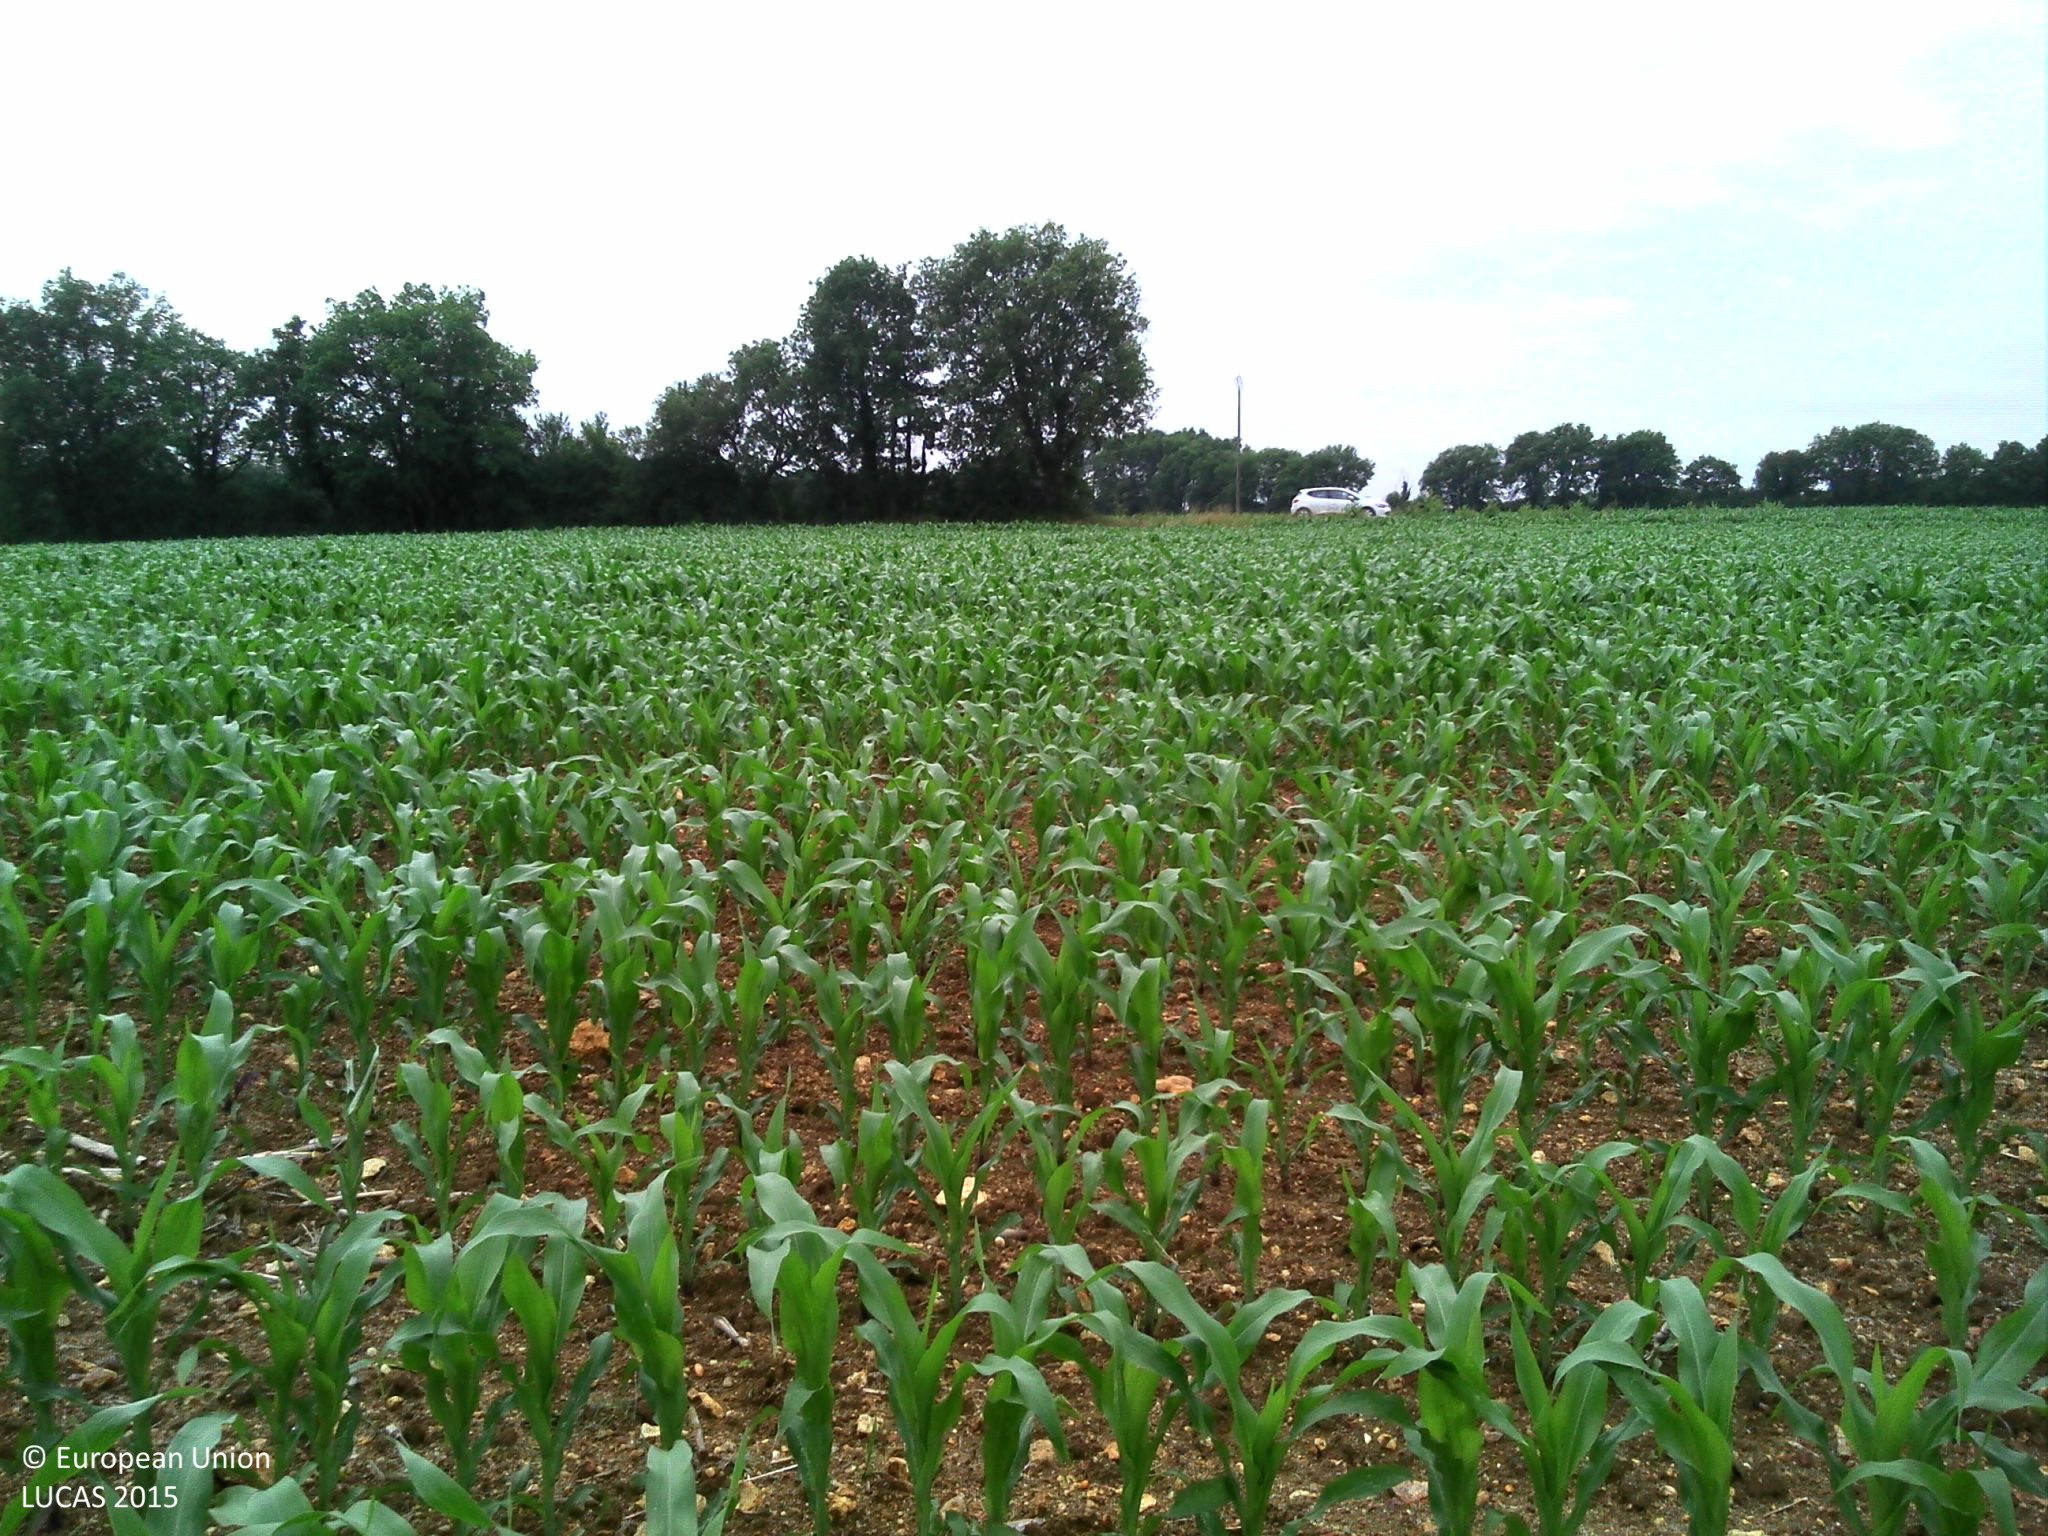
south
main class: Cropland
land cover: Maize
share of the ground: 50 - 75 %
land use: Agriculture (excluding fallow land and kitchen gardens)
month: June
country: FR
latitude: 46.4928
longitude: 0.5372
